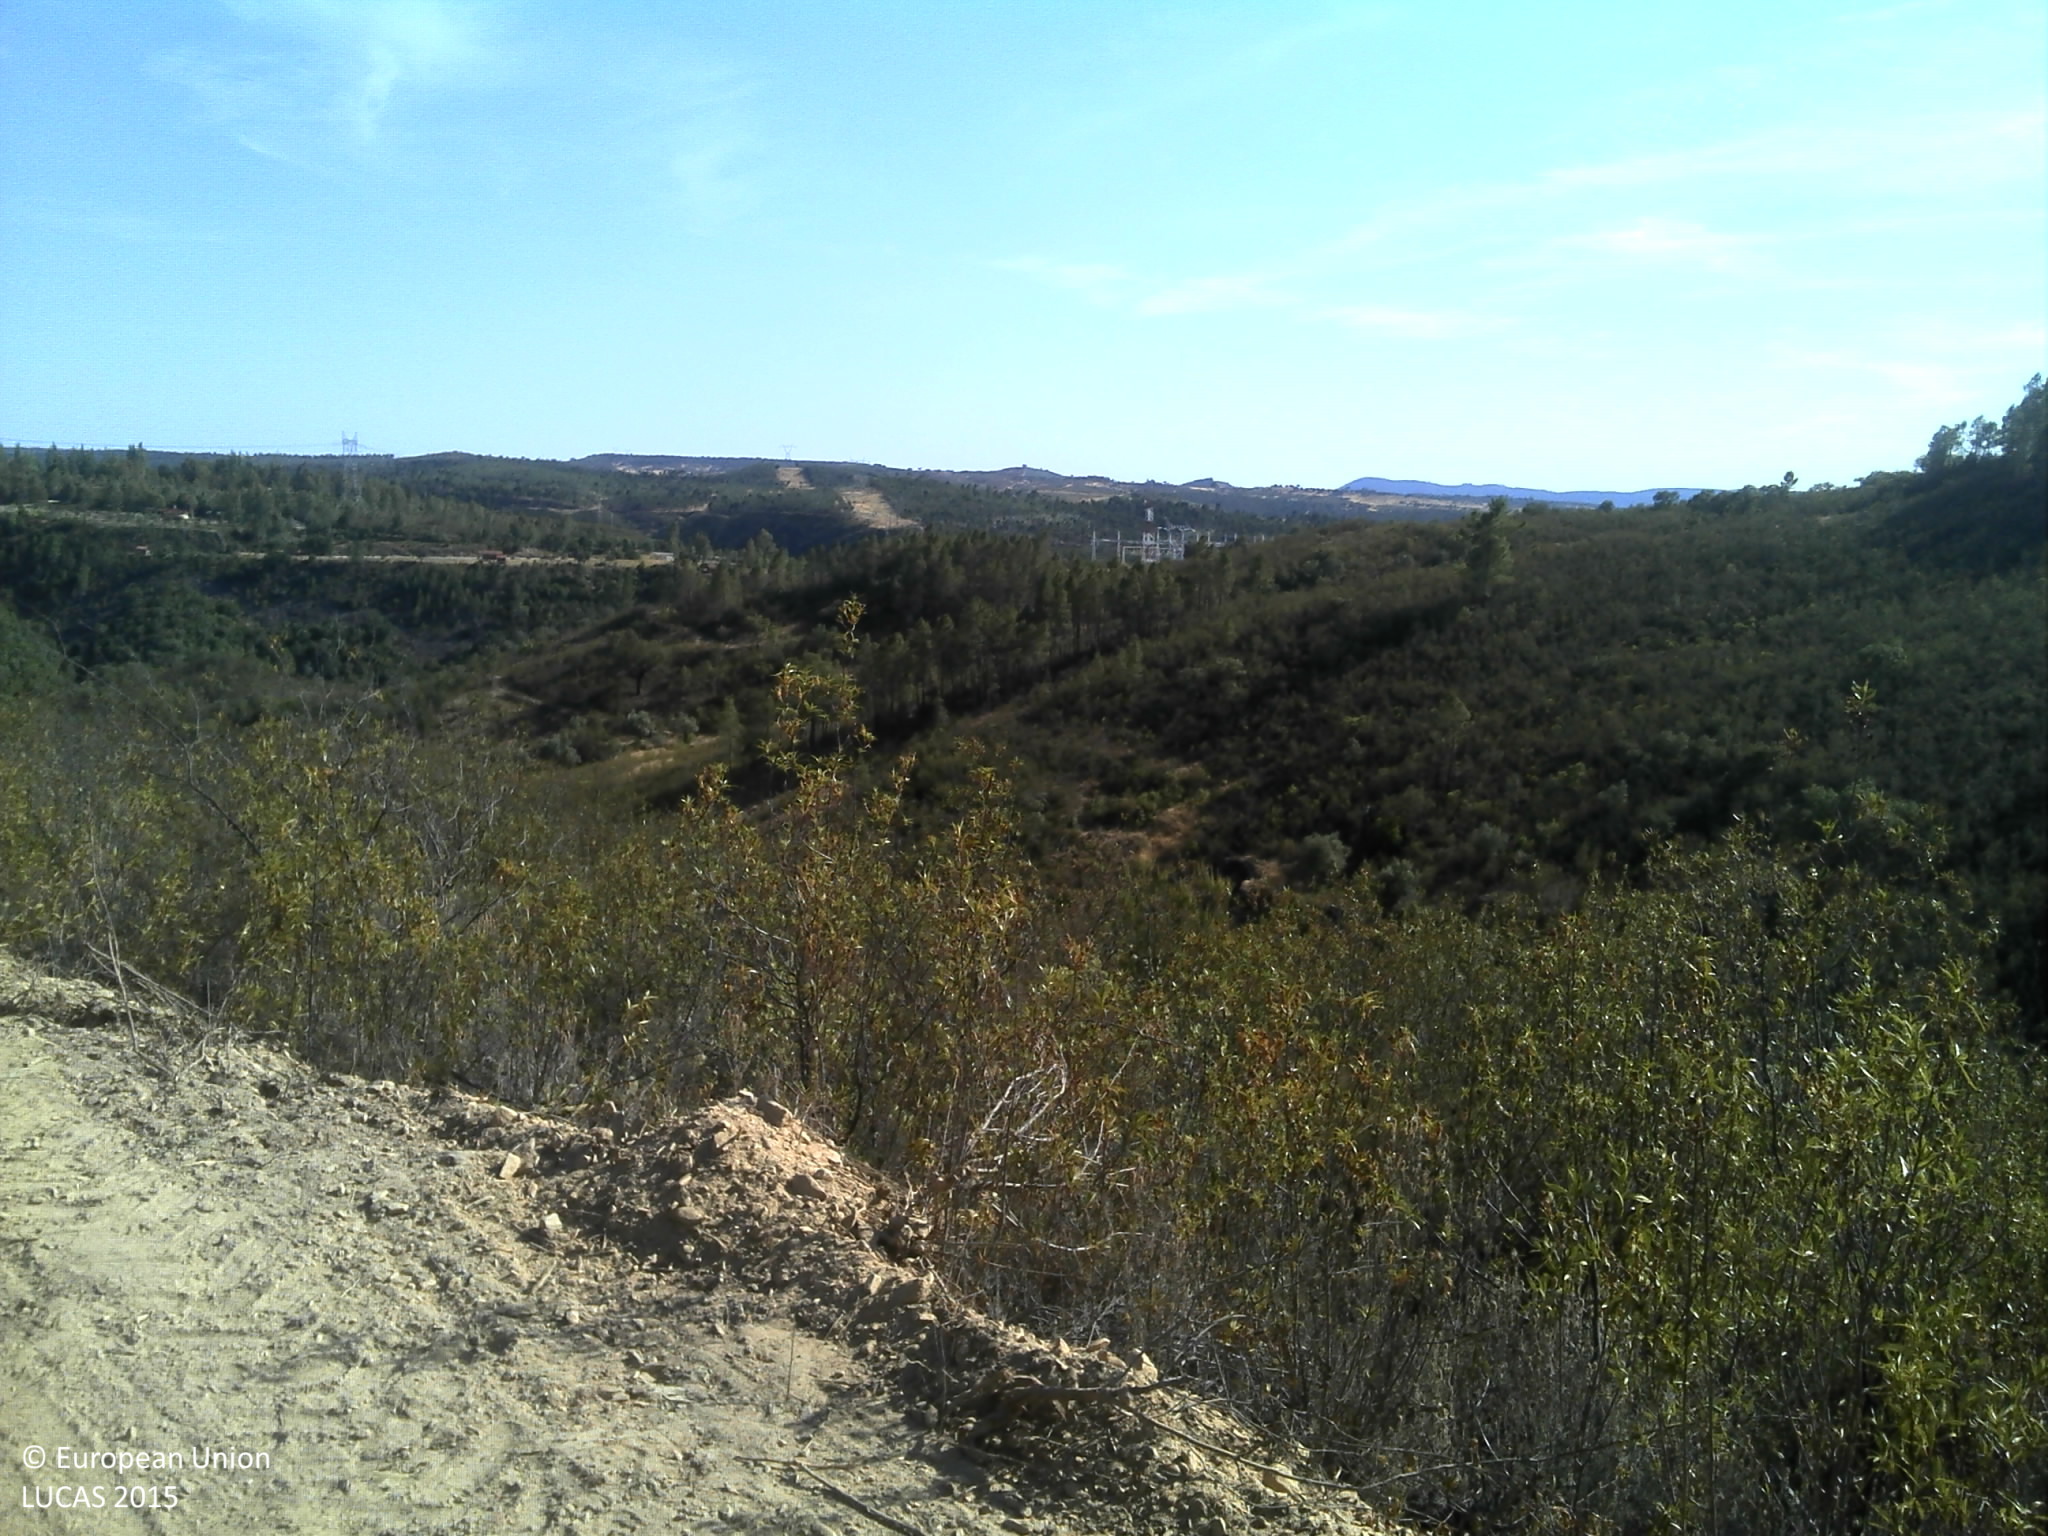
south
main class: Shrubland
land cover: Shrubland without tree cover
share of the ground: > 75 %
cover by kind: shrubs 85 %, unconsolidated bare surface 10 %, herbaceous plants 5 %
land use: Abandoned areas
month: July
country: PT
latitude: 39.6728
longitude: -7.5256
